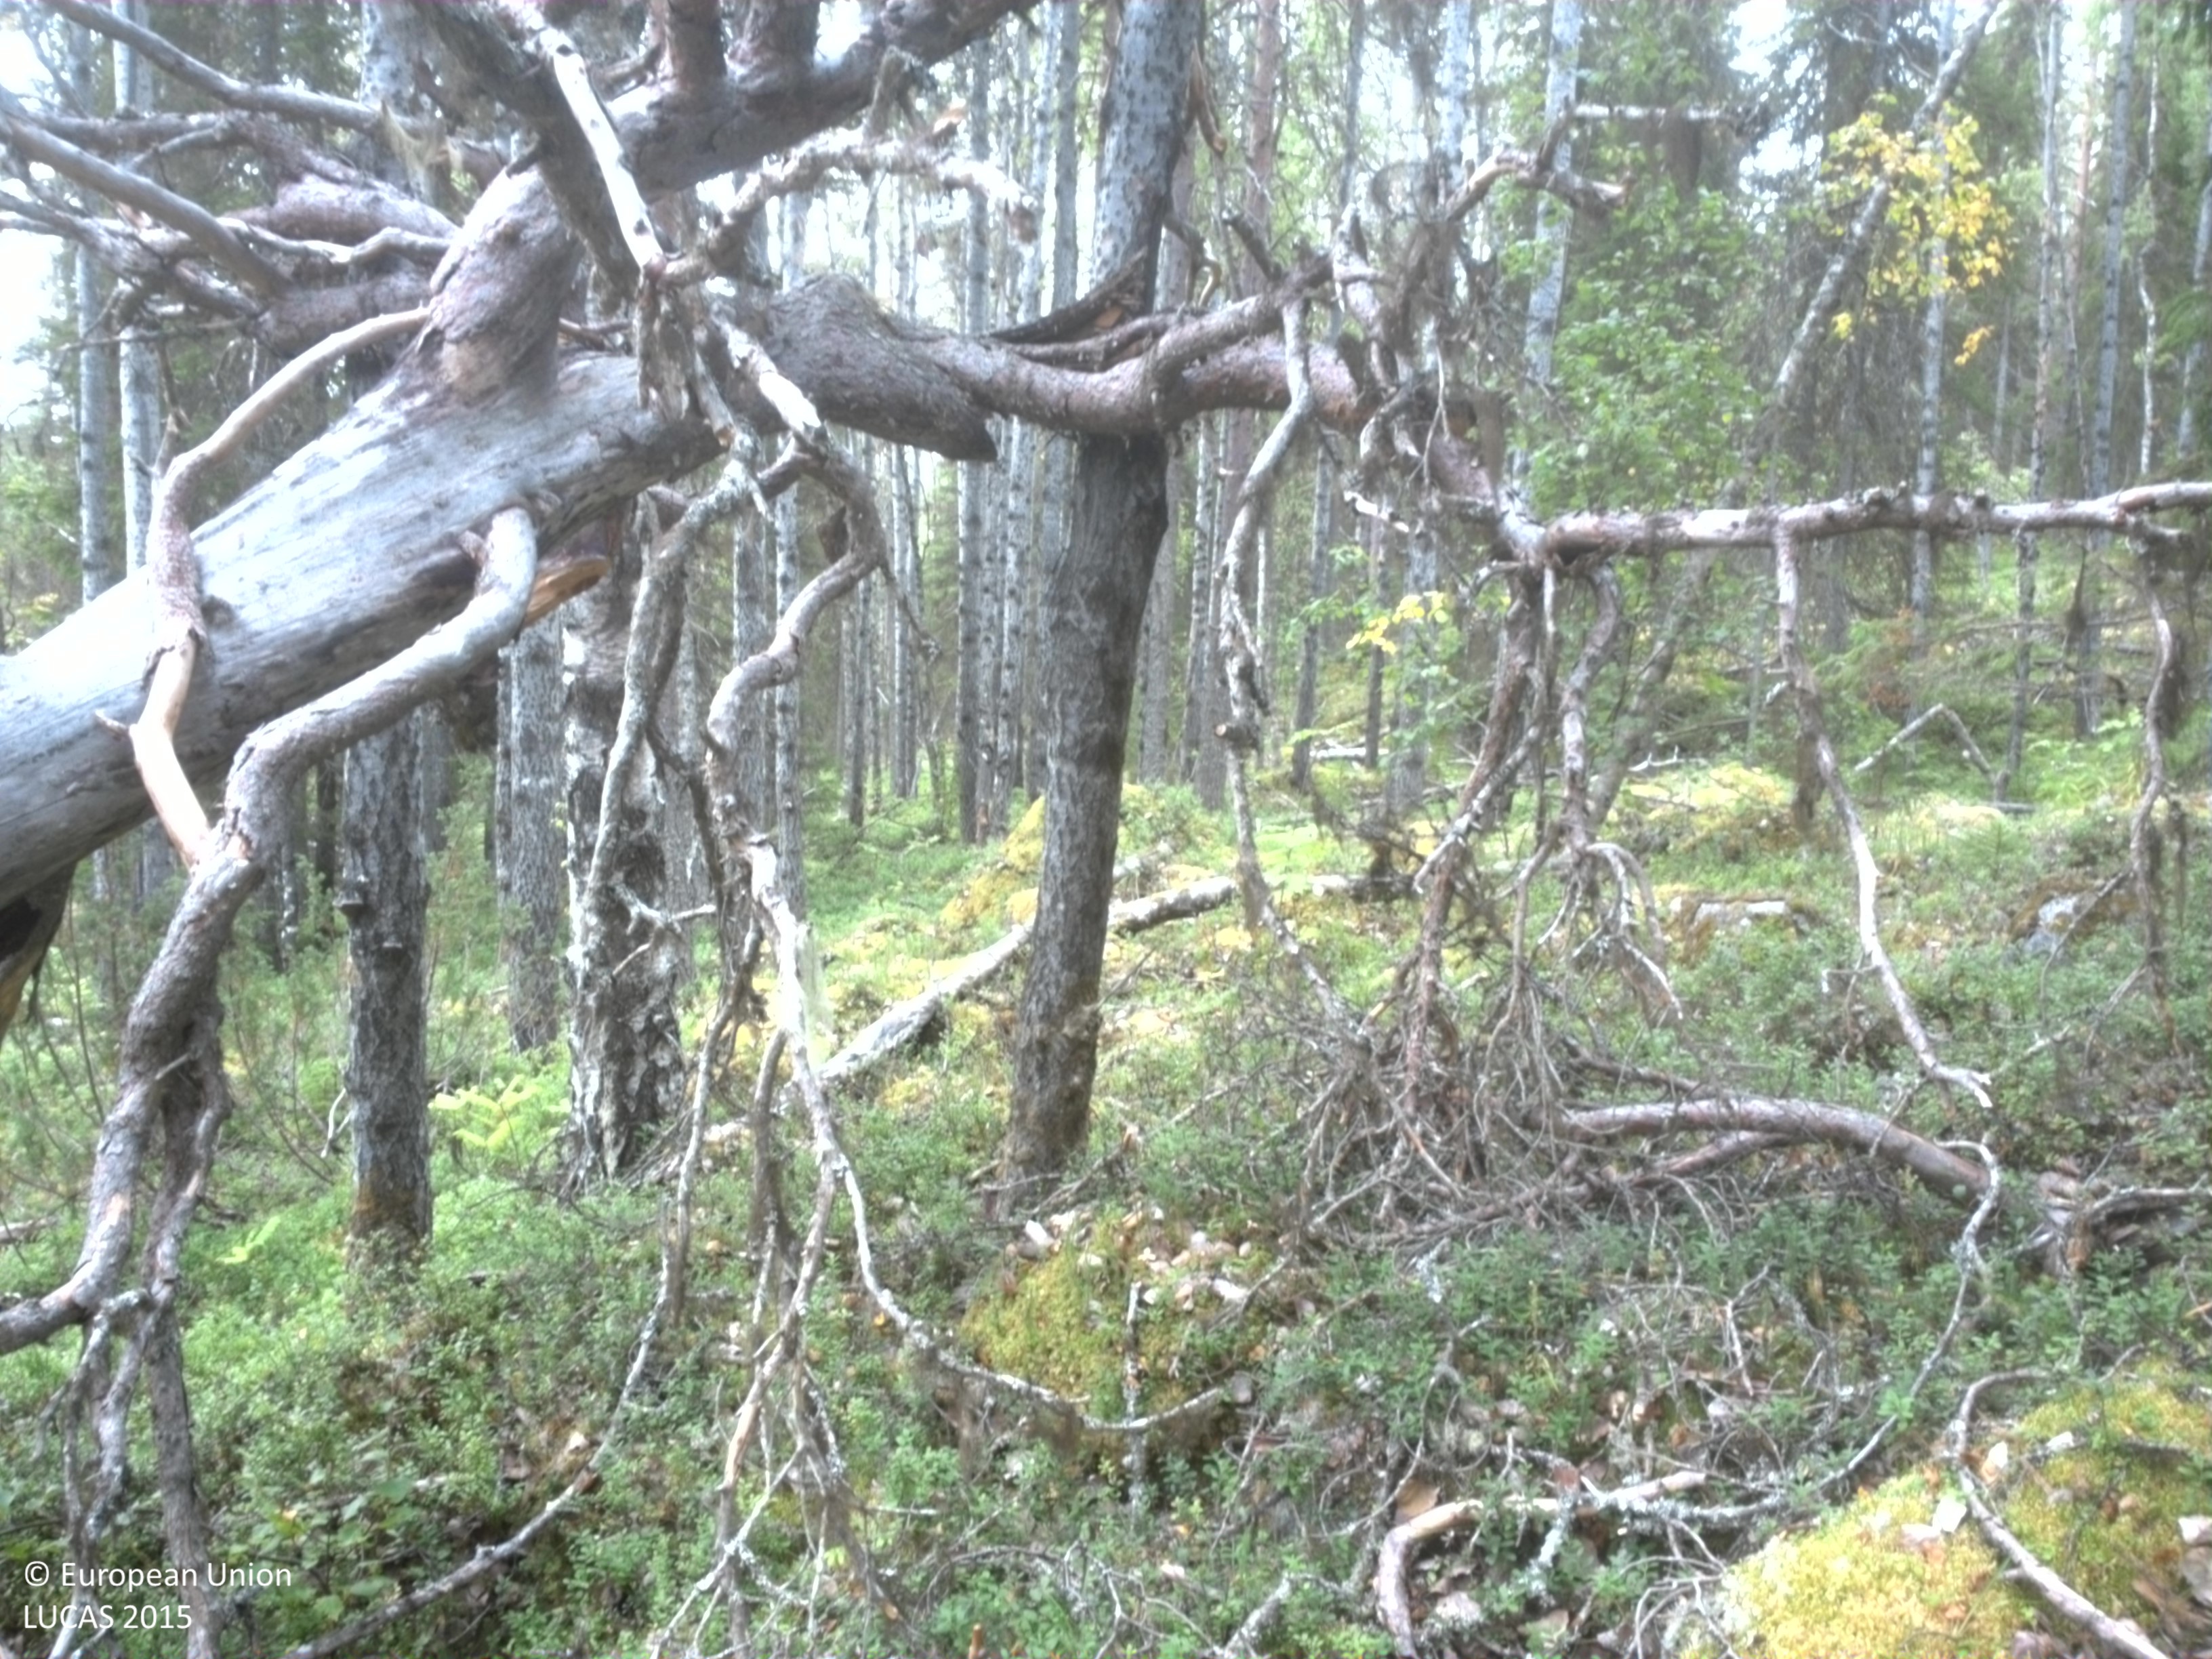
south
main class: Woodland
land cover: Spruce dominated mixed woodland
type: boreal forest
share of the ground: 50 - 75 %
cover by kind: coniferous forest trees 45 %, shrubs 30 %, broadleaved forest trees 15 %, lichens and mosses 10 %
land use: Forestry
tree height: > 5 m
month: September
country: SE
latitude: 64.6064
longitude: 19.7739
